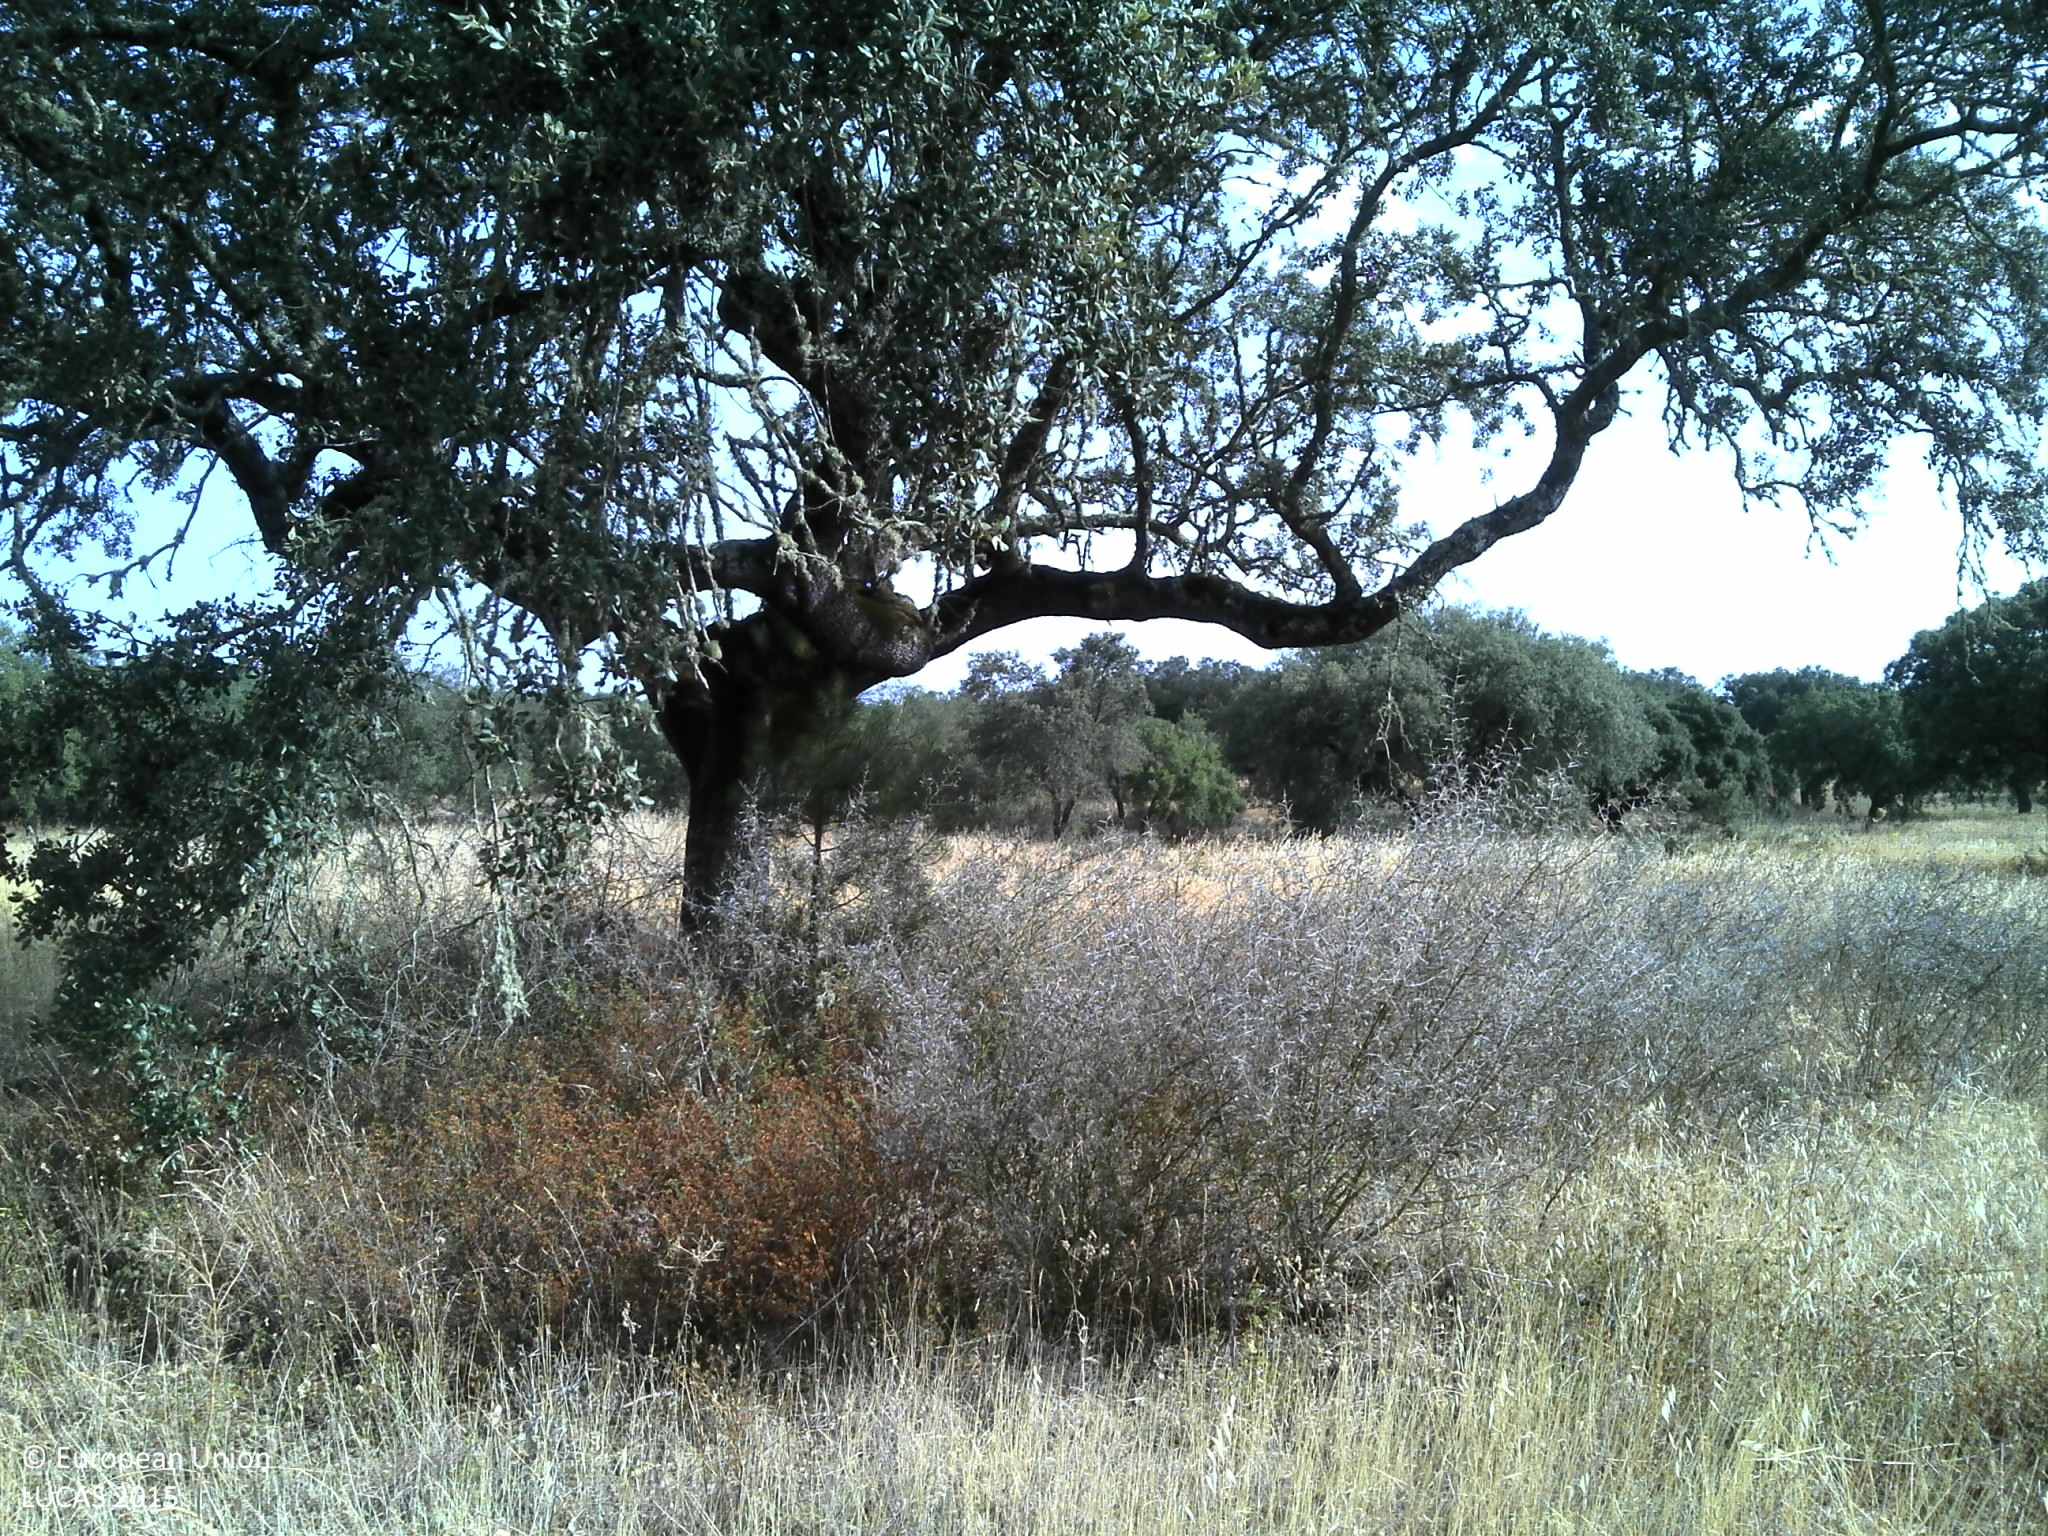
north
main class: Woodland
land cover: Broadleaved woodland
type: broadleaved evergreen forest
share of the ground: 10 - 25 %
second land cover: Grassland without tree/shrub cover
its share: 50 - 75 %
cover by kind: herbaceous plants 60 %, broadleaved forest trees 20 %, unconsolidated bare surface 20 %
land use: Forestry
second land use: Agriculture (excluding fallow land and kitchen gardens)
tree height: > 5 m
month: July
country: PT
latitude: 38.7331
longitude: -7.8133
